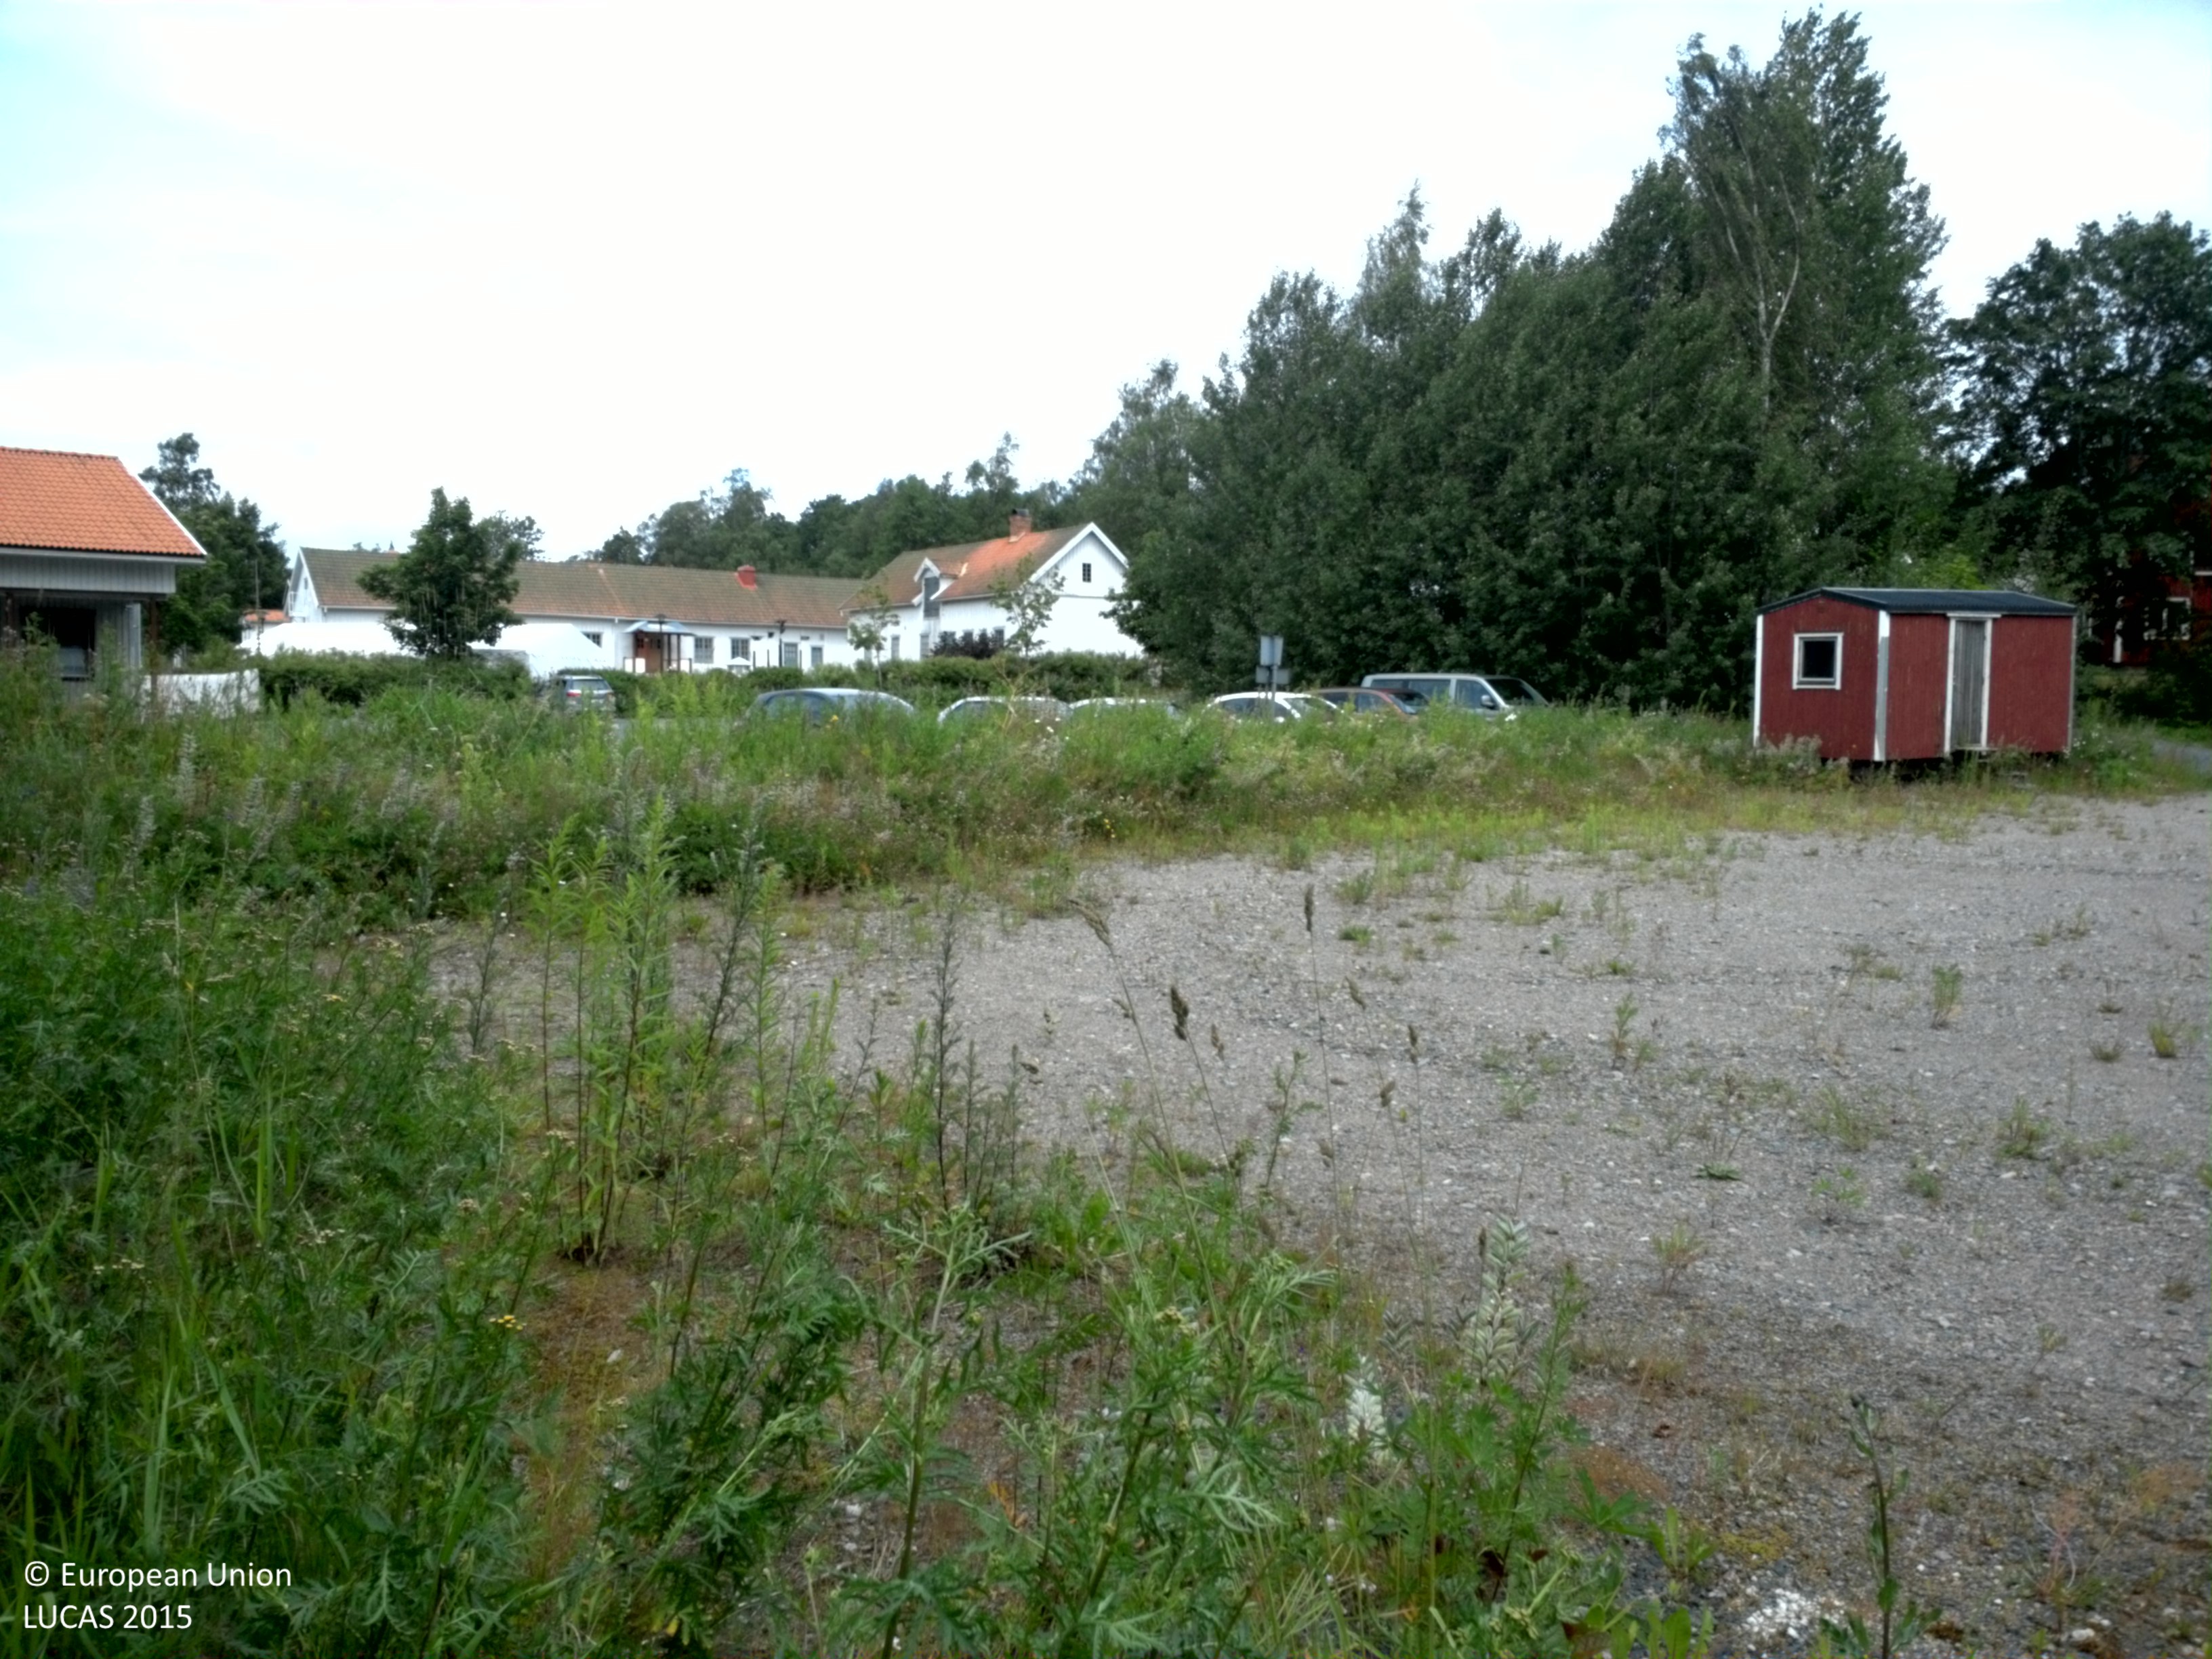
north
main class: Grassland
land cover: Grassland without tree/shrub cover
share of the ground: > 75 %
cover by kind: herbaceous plants 90 %, shrubs 5 %, unconsolidated bare surface 5 %
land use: Semi-natural and natural areas not in use
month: July
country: SE
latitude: 57.5061
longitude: 14.7191
